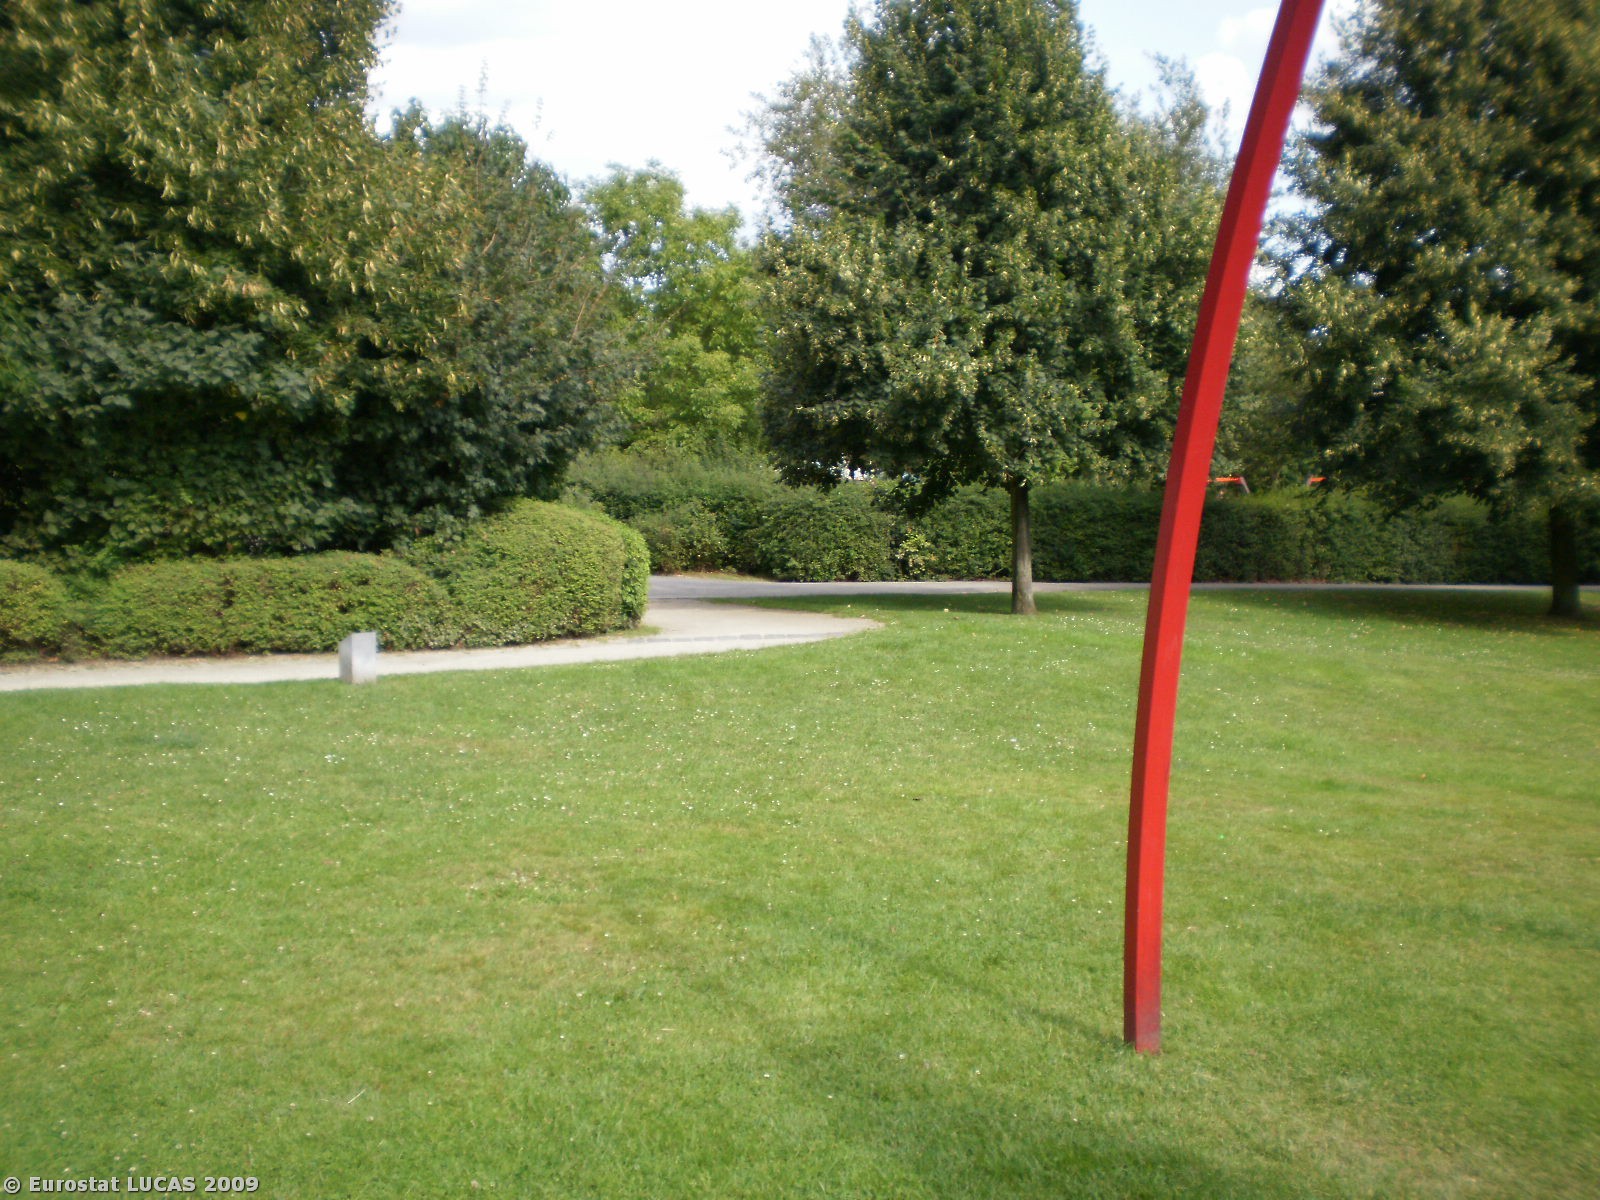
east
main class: Grassland
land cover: Grassland with sparse tree/shrub cover
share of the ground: > 75 %
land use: Amenities, museums, leisure
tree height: > 5 m
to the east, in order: Grassland with sparse tree/shrub cover; Tracks; Paved roads, cycling and walking lanes; Managed hedges; Grassland with sparse tree/shrub cover; Managed hedges; Grassland with sparse tree/shrub cover; Broadleaved woodland; Paved roads, cycling and walking lanes; Managed hedges; Grassland with sparse tree/shrub cover; Artificial constructions in urban areas; Grassland with sparse tree/shrub cover; Managed hedges; Artificial constructions in urban areas; Lines of trees; Paved roads, cycling and walking lanes; Lines of trees; Paved roads, cycling and walking lanes; Lines of trees; Other structural elements; Broadleaved woodland
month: August
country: BE
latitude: 50.8528
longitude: 4.2991
